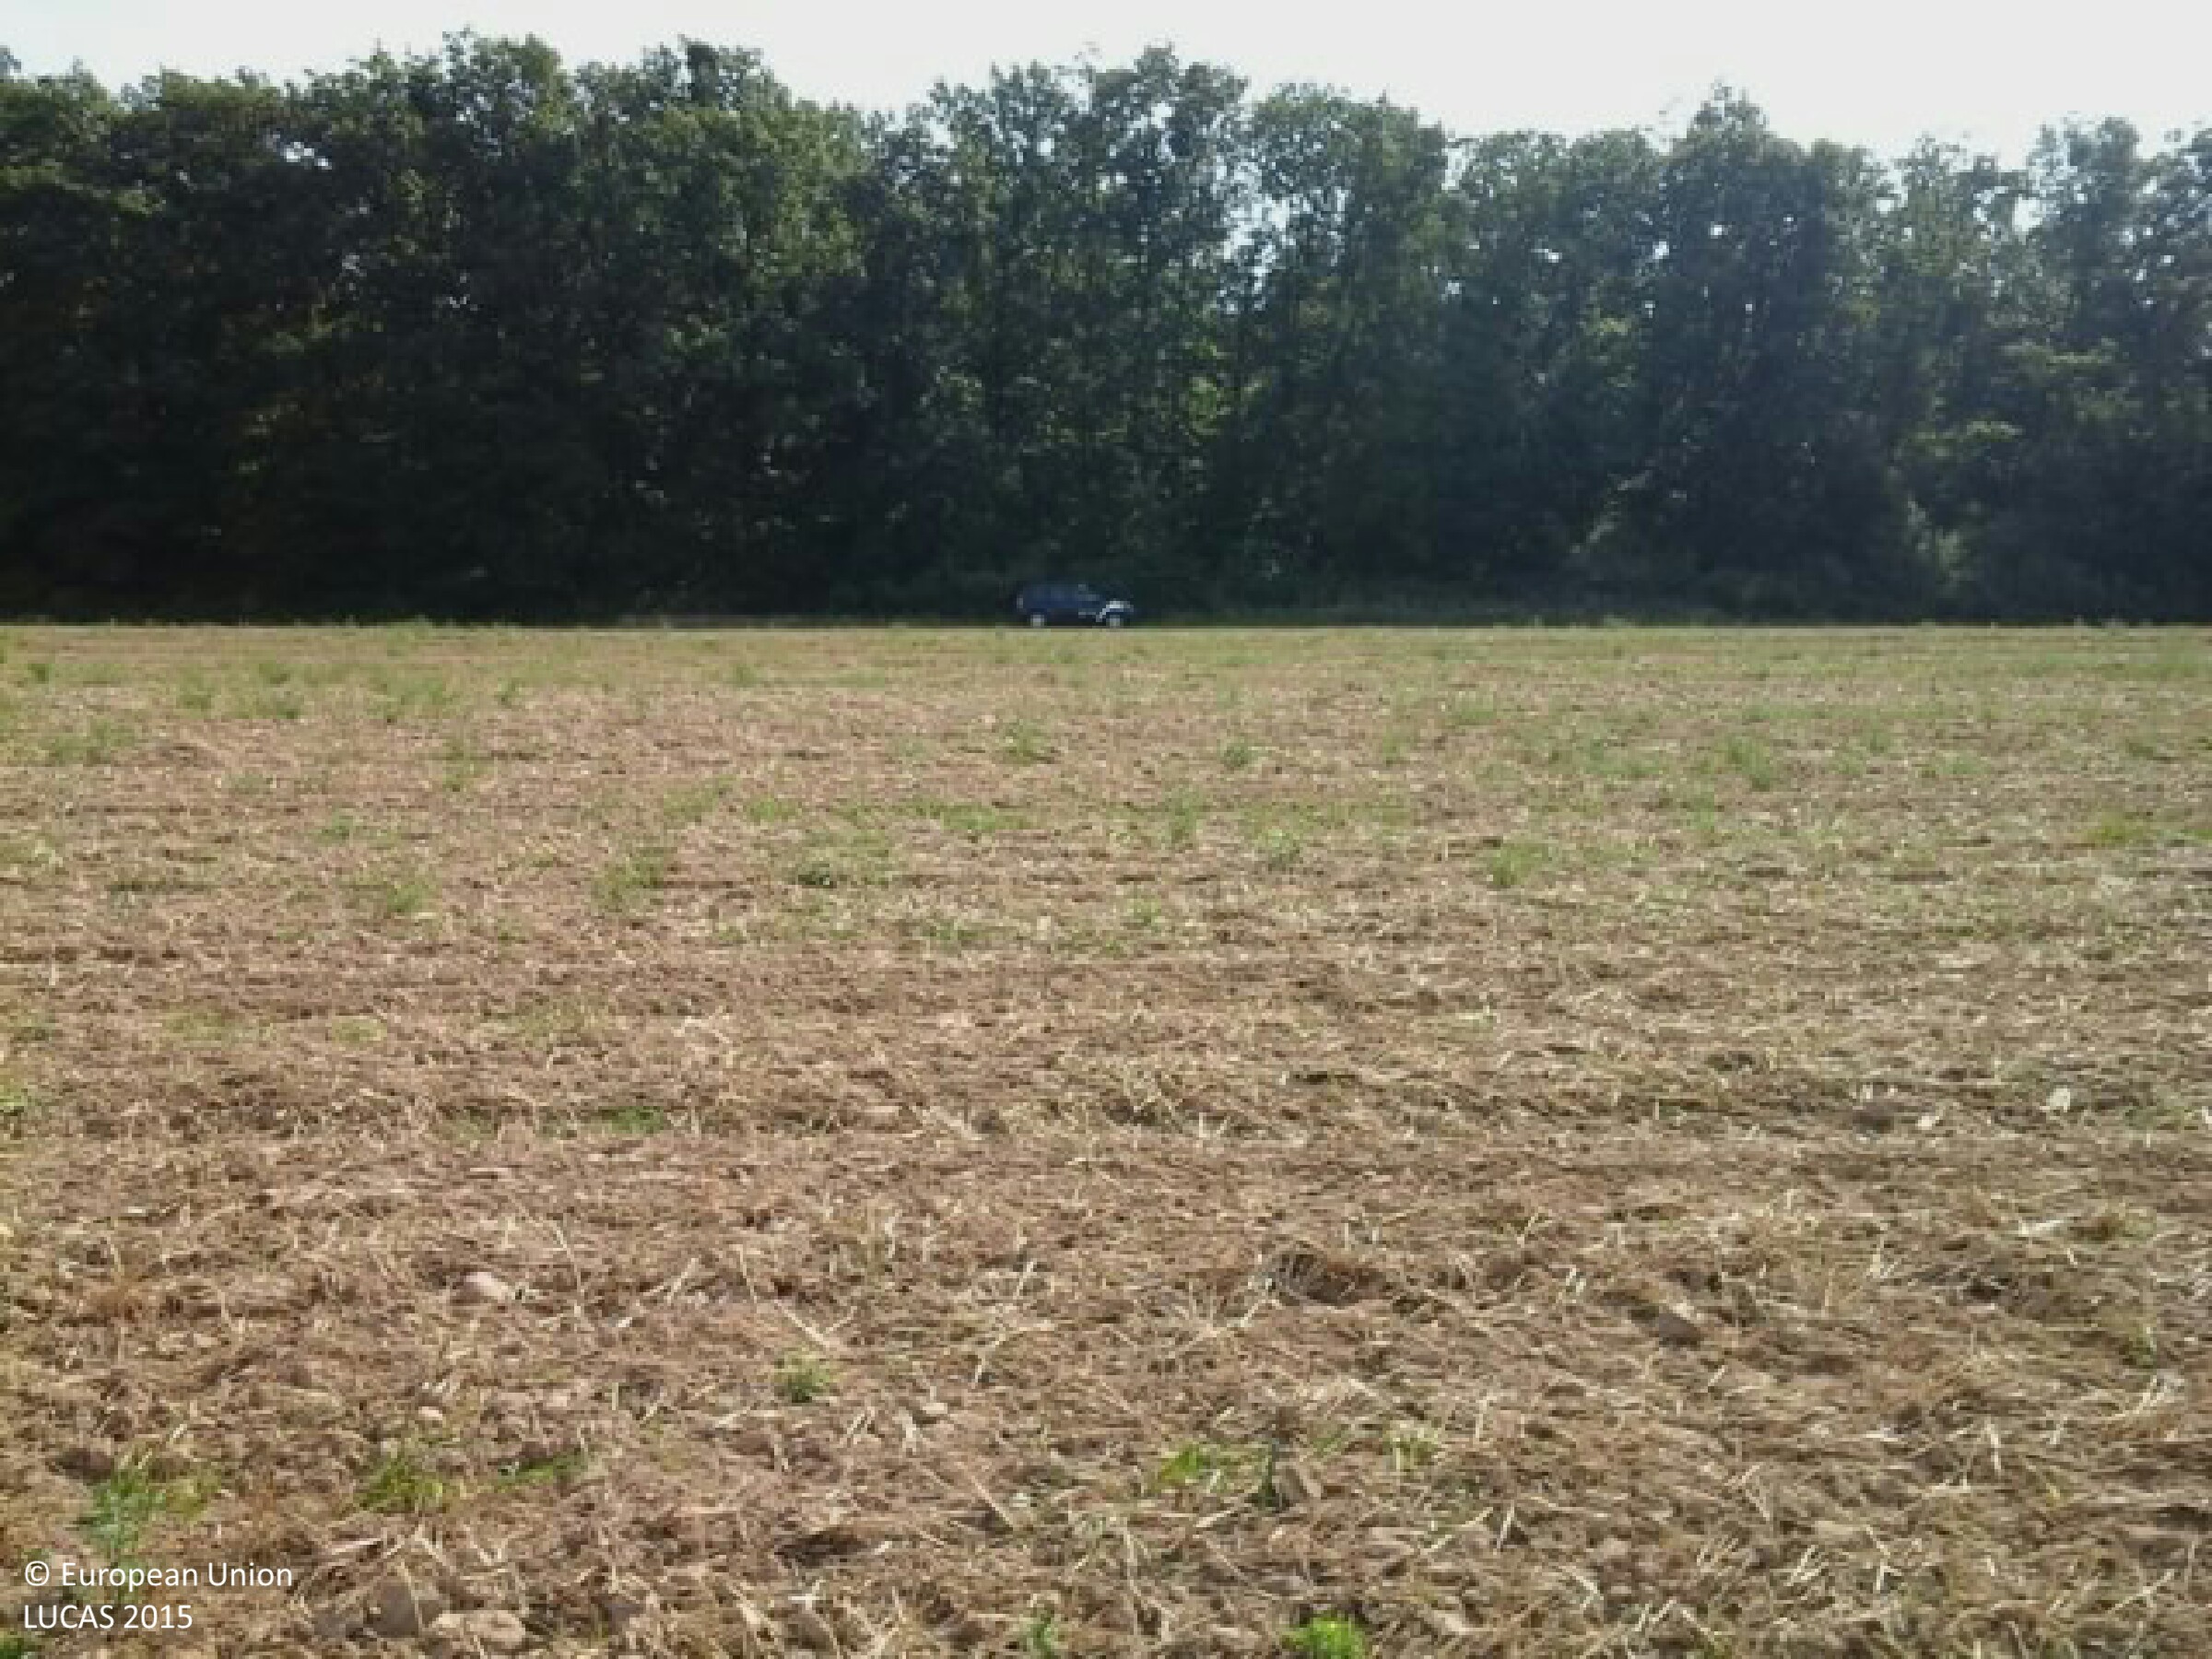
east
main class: Cropland
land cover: Common wheat
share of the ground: 25 - 50 %
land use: Agriculture (excluding fallow land and kitchen gardens)
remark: Harvested field
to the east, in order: Common wheat; Broadleaved woodland
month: August
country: HU
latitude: 46.5522
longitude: 17.3213
